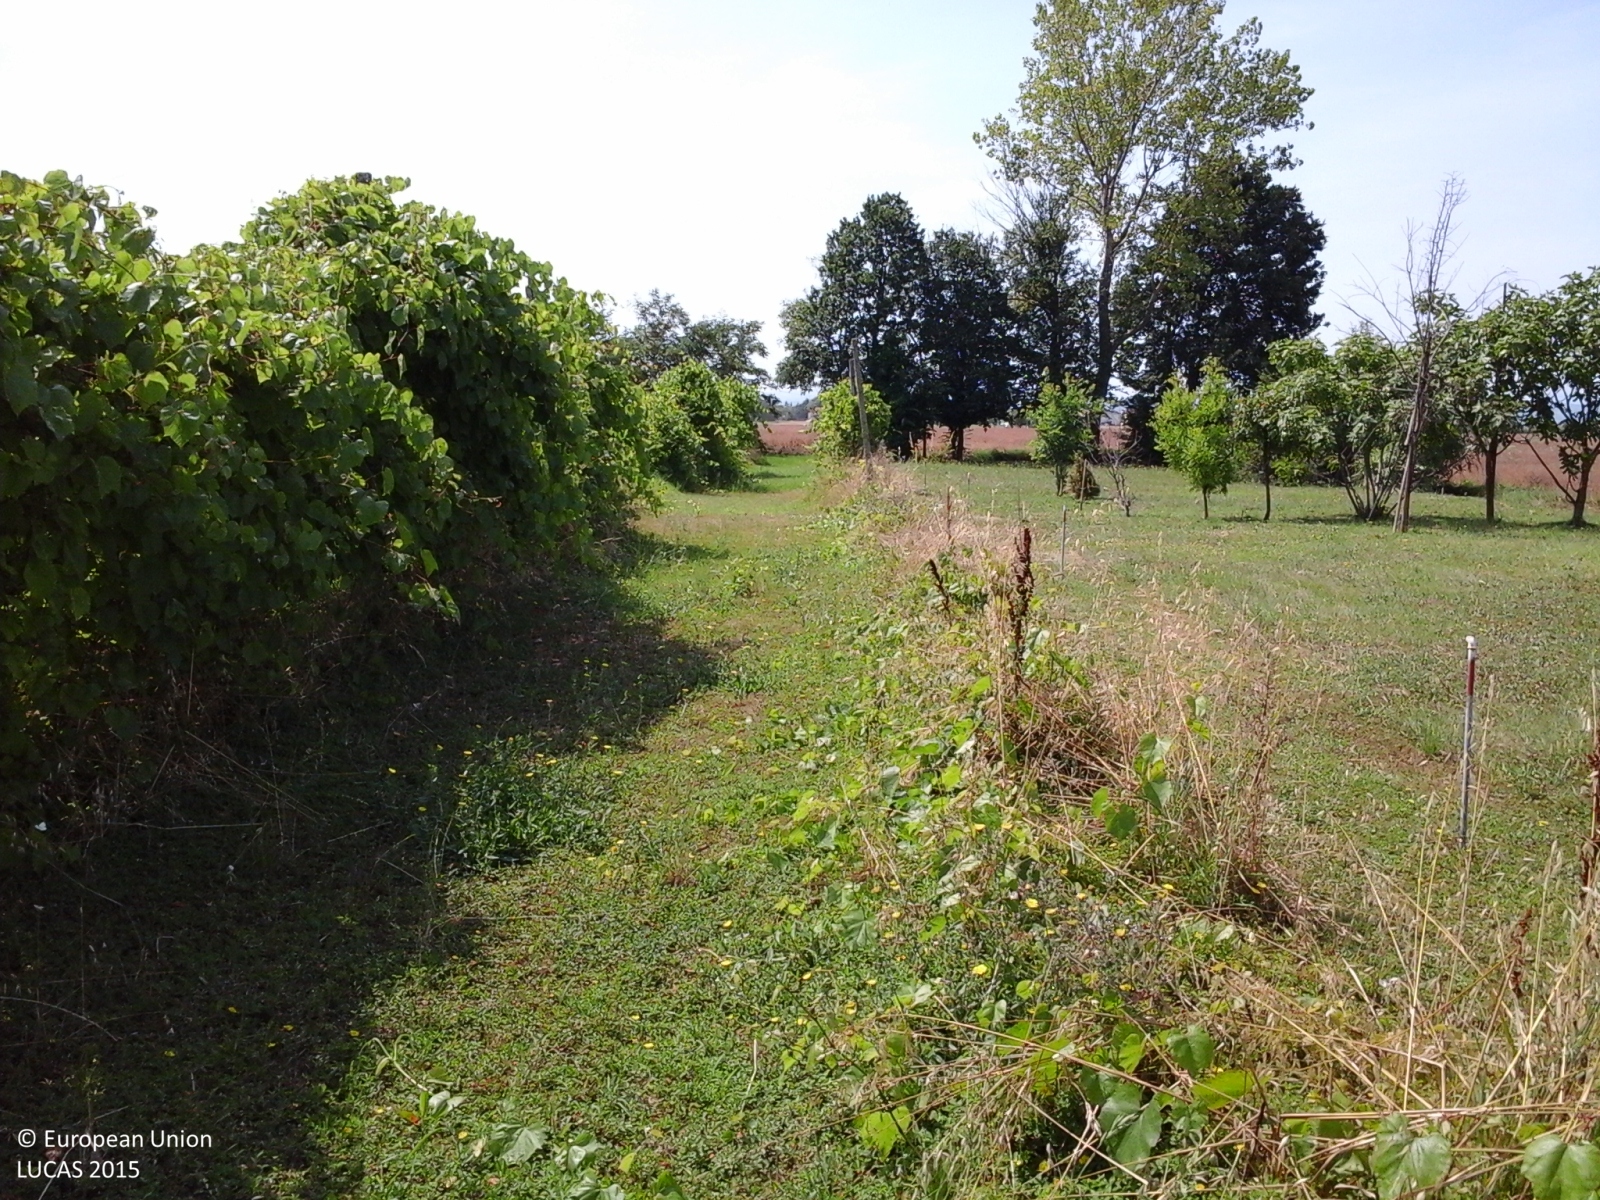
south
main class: Cropland
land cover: Vineyards
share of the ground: > 75 %
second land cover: Grassland without tree/shrub cover
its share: > 75 %
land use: Agriculture (excluding fallow land and kitchen gardens)
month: June
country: IT
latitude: 44.1974
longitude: 12.3596
